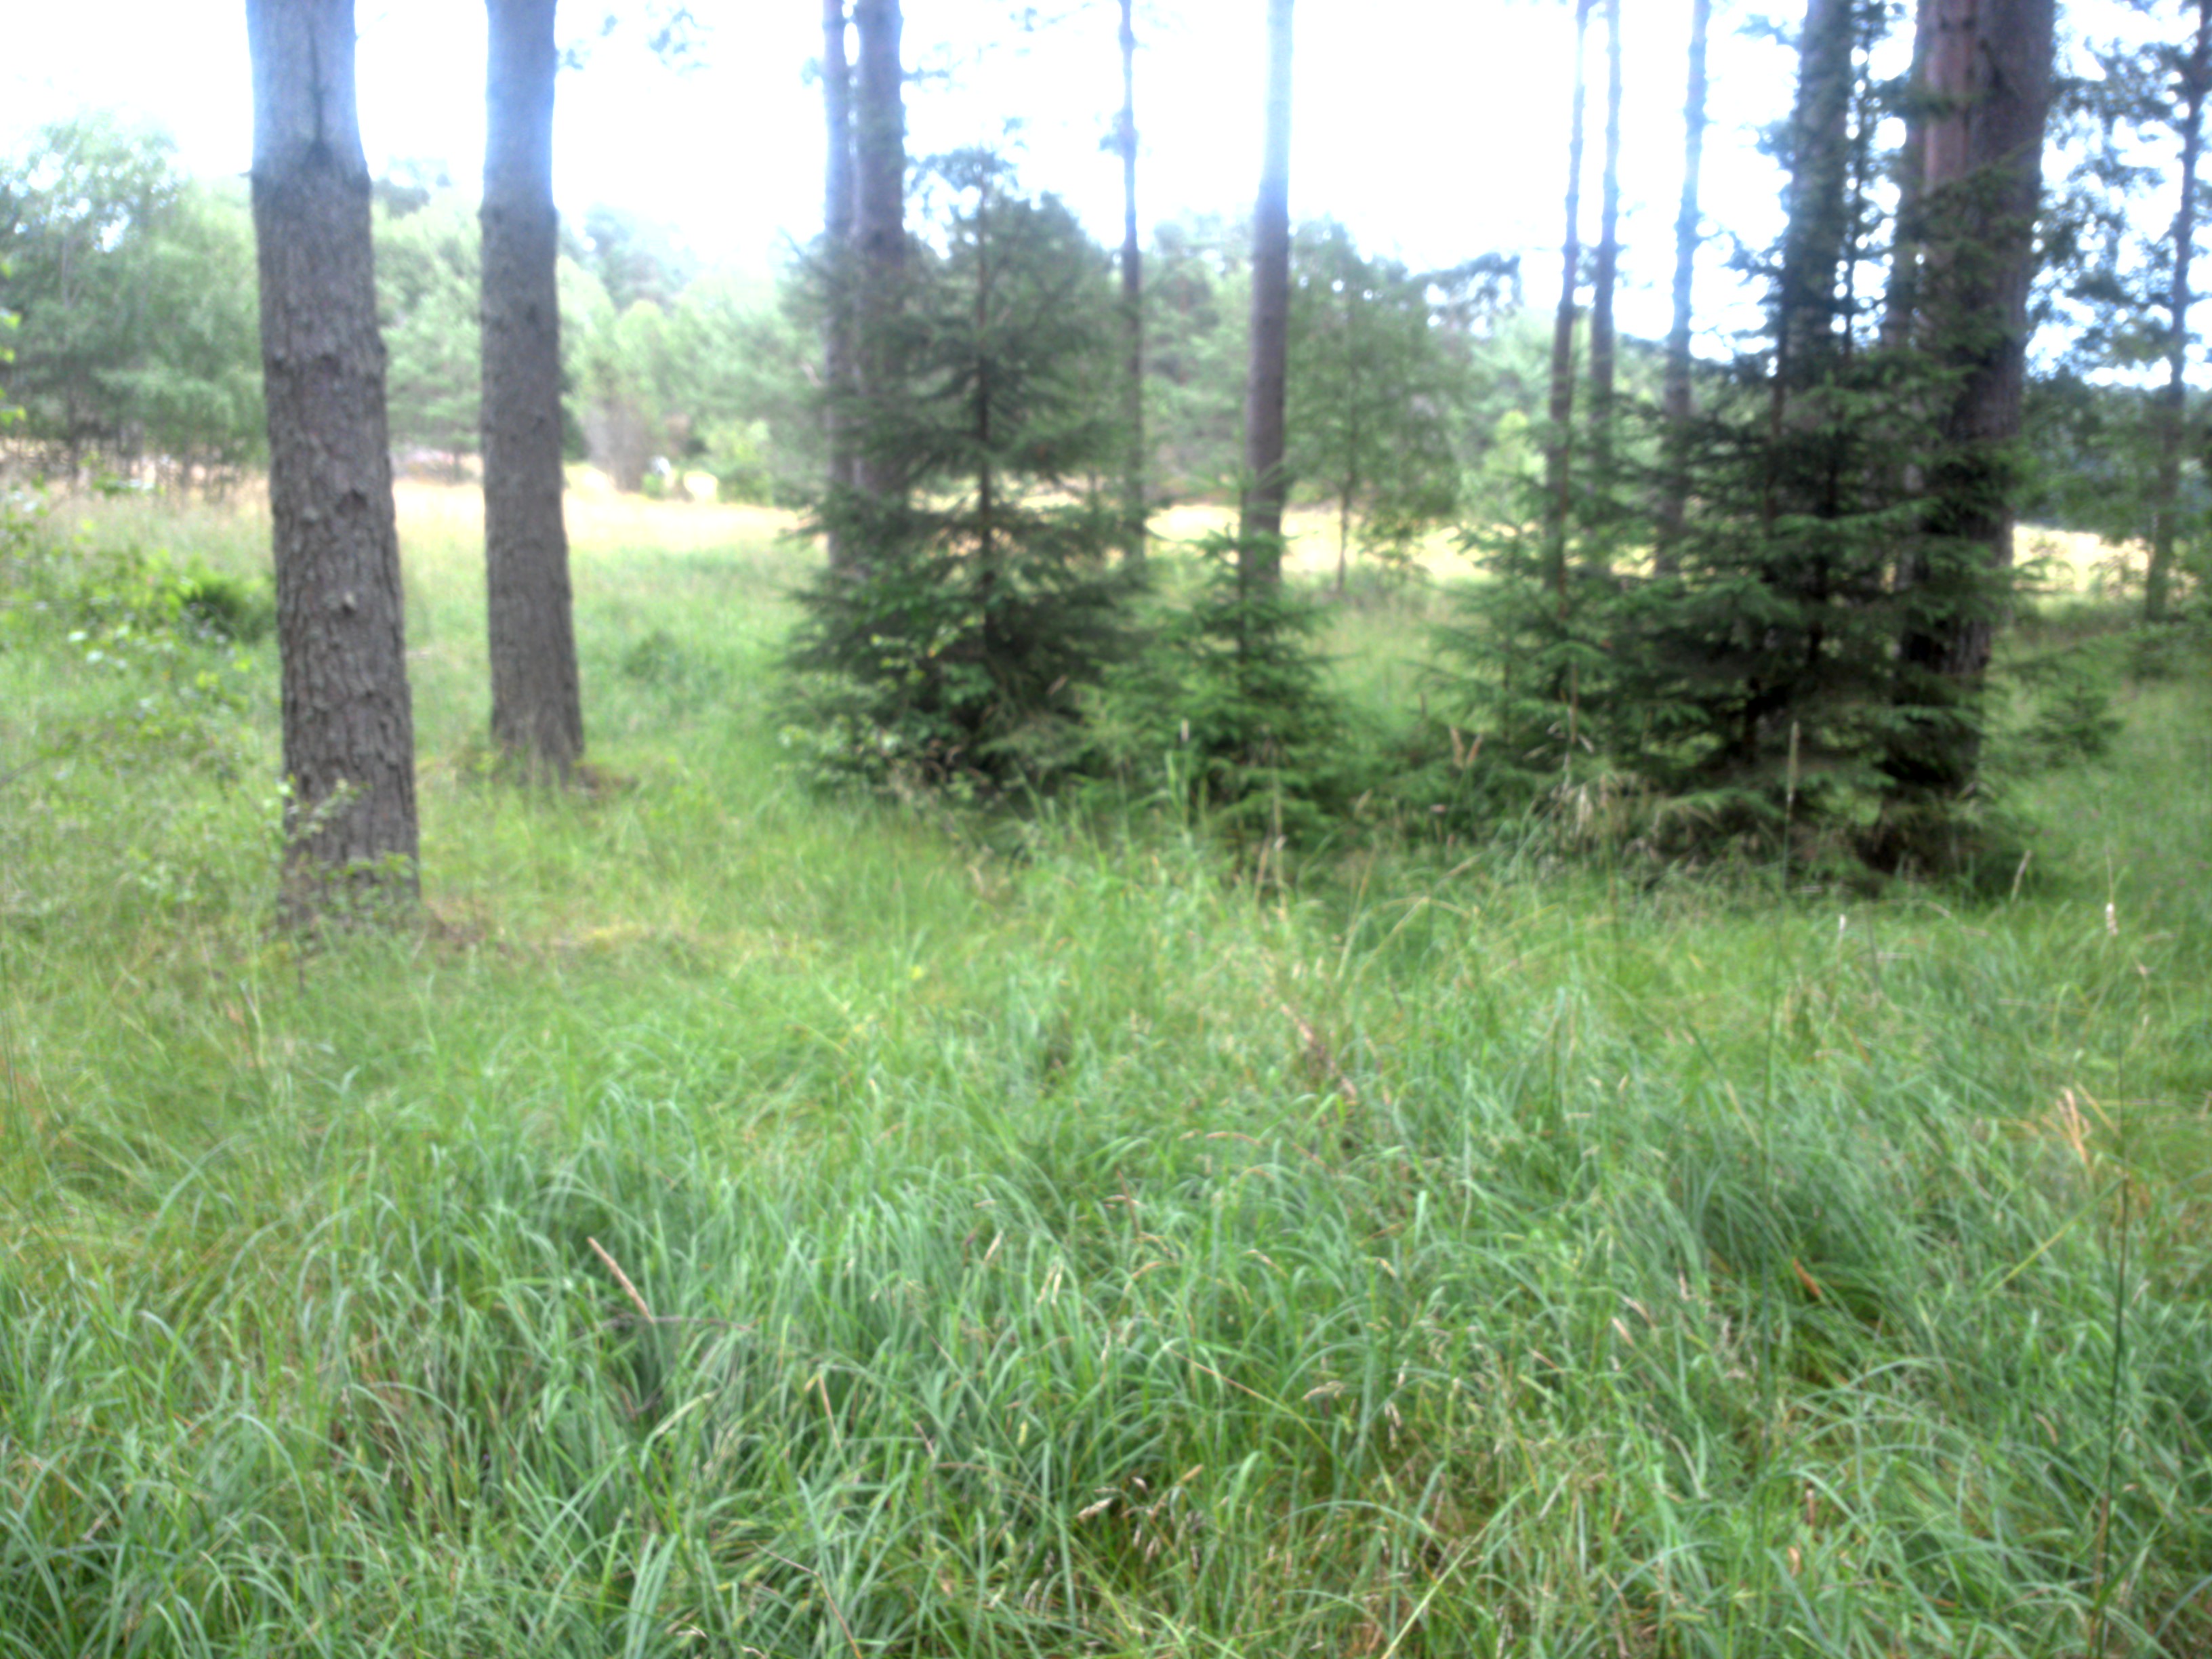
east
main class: Woodland
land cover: Pine dominated coniferous woodland
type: boreal forest
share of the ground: 50 - 75 %
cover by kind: coniferous forest trees 65 %, herbaceous plants 35 %
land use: Forestry
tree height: > 5 m
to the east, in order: Pine dominated coniferous woodland; Ditches and canals; Paved roads, cycling and walking lanes; Ditches and canals; Grass margins; Fences; Grassland without tree/shrub cover; Ditches and canals; Pine dominated coniferous woodland; Fences; Pine dominated coniferous woodland; Broadleaved woodland; Pine dominated coniferous woodland; Electric lines; Pine dominated coniferous woodland; Grassland without tree/shrub cover
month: July
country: SE
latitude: 59.1452
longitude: 18.1988
